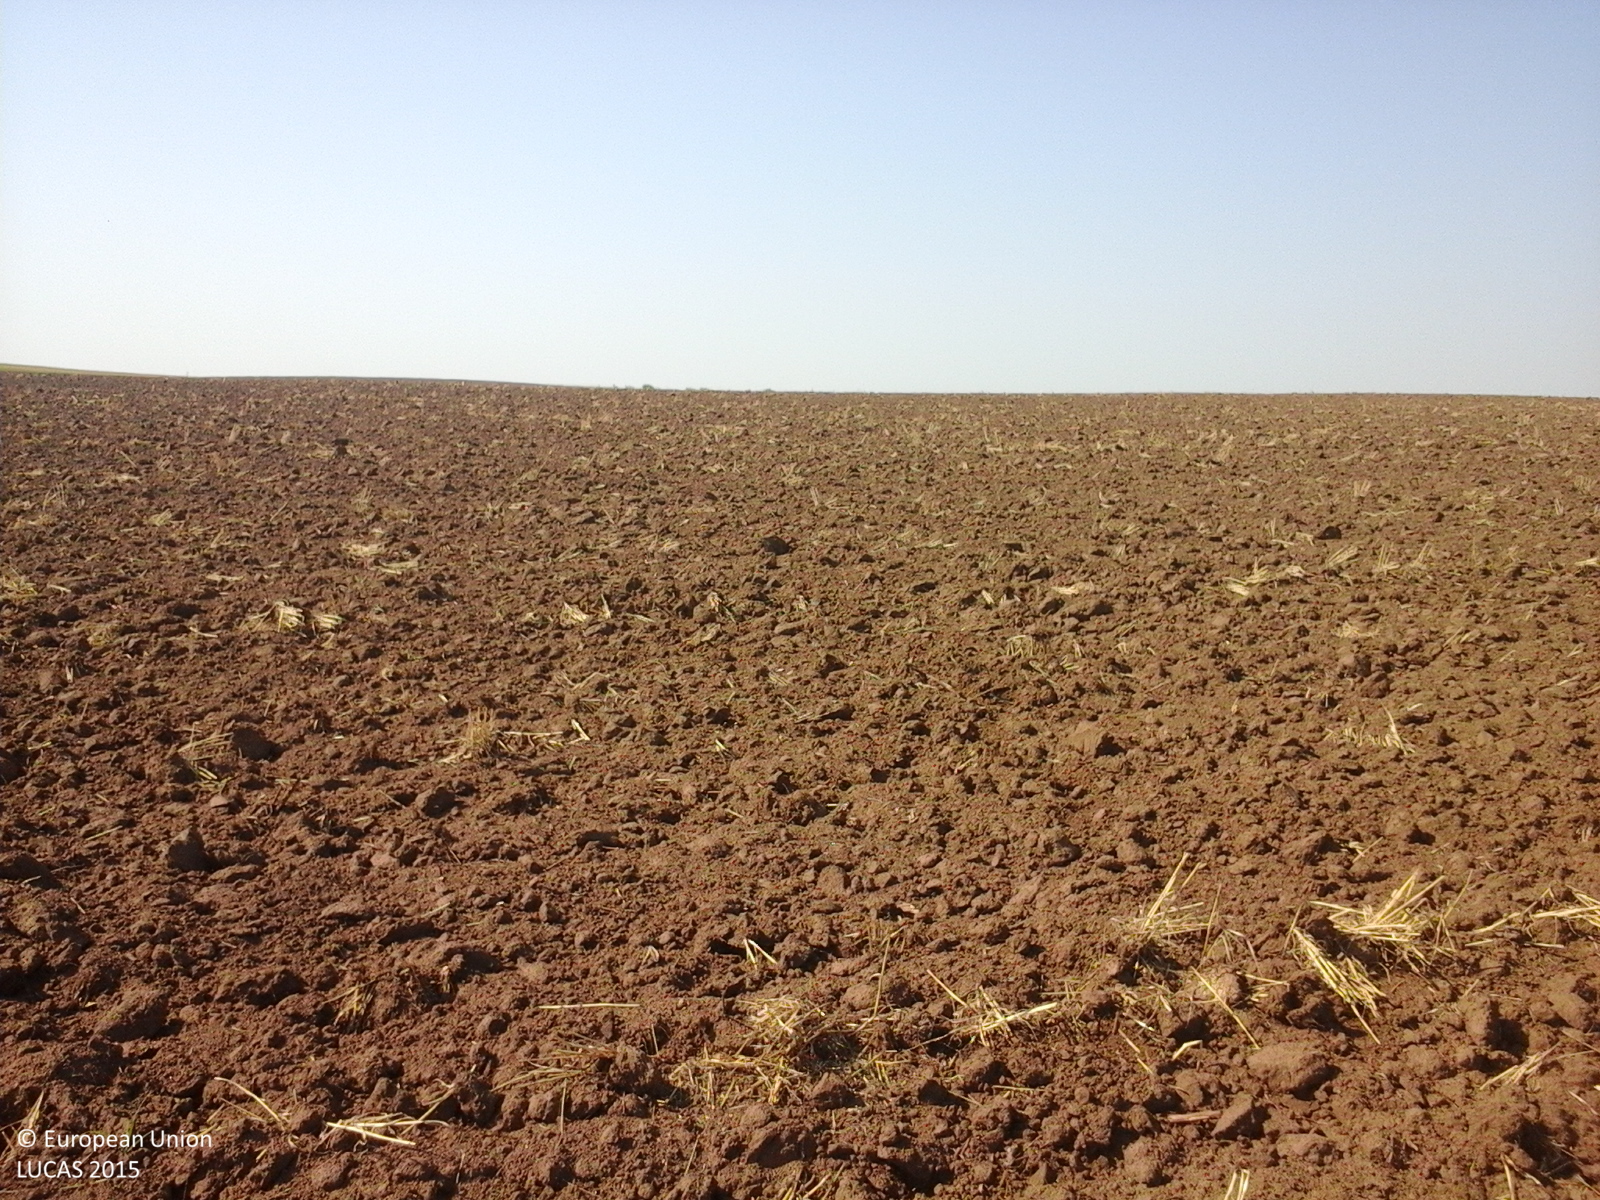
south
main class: Cropland
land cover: Common wheat
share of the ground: < 10 %
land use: Agriculture (excluding fallow land and kitchen gardens)
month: July
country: RO
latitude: 44.5795
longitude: 27.6152
